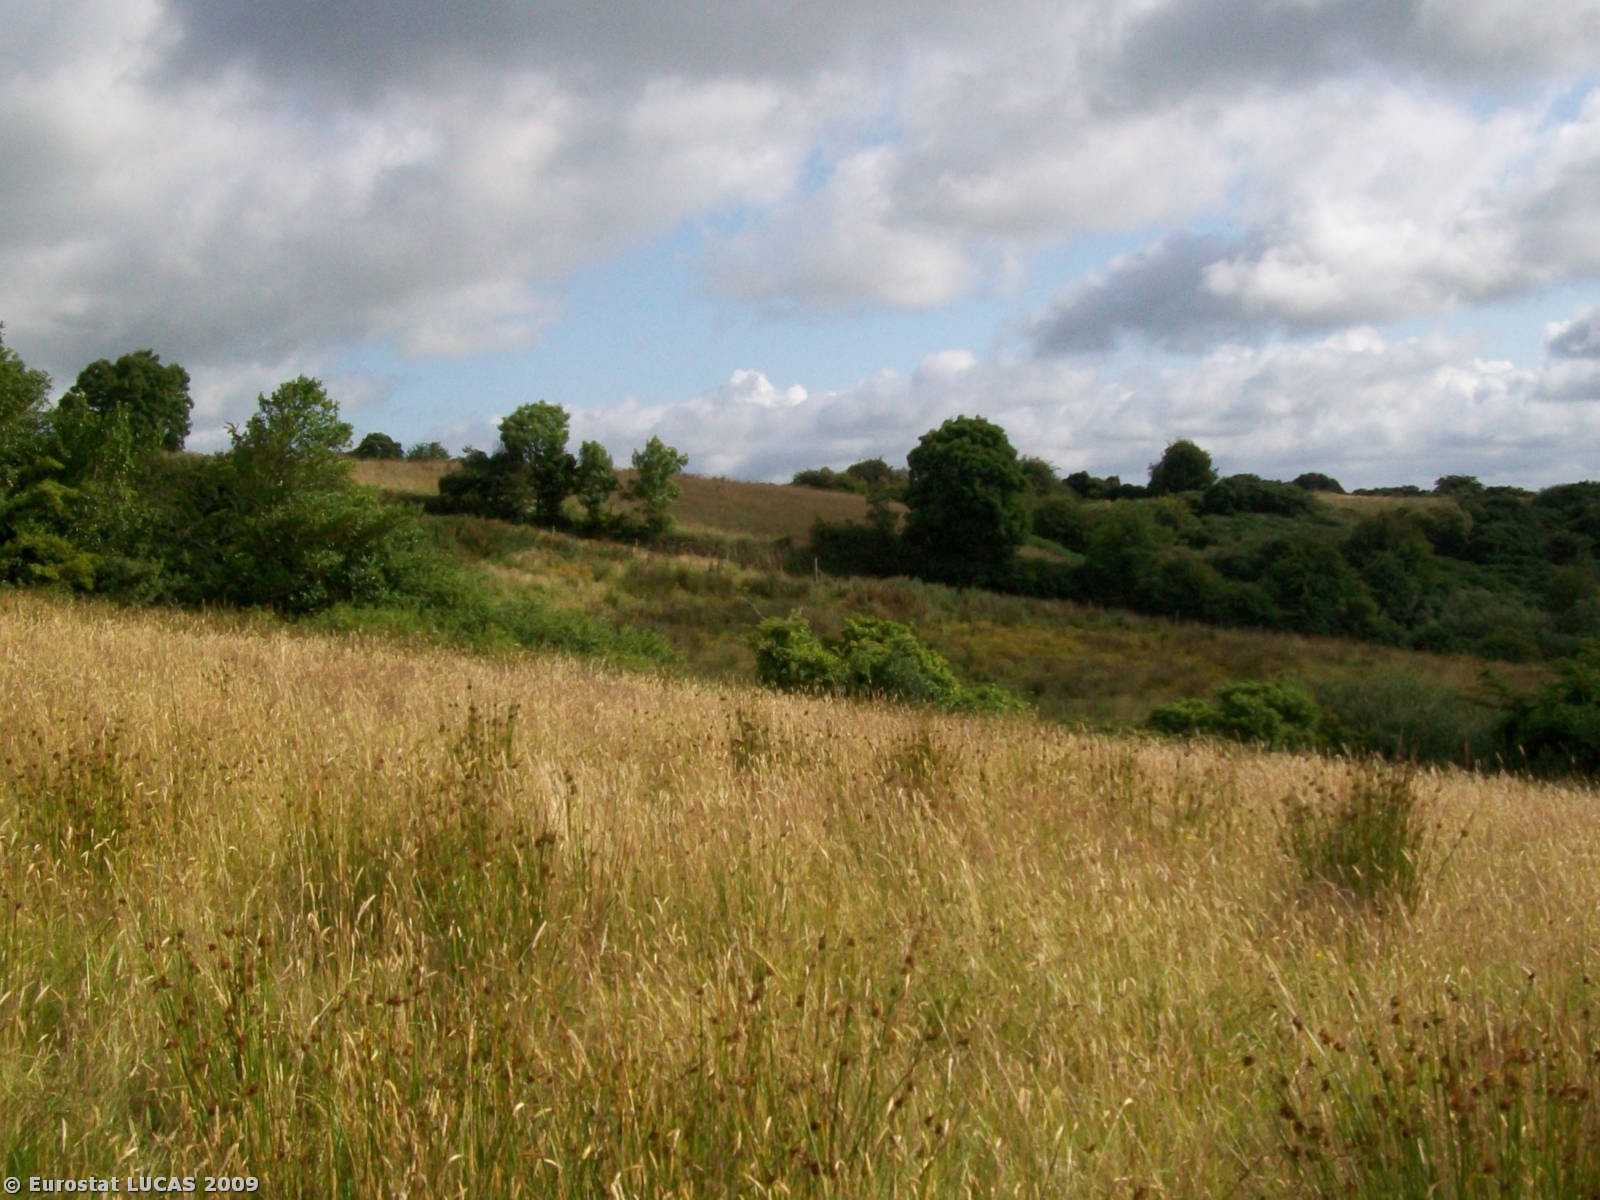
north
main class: Grassland
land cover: Grassland without tree/shrub cover
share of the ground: > 75 %
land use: Agriculture (excluding fallow land and kitchen gardens)
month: July
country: IE
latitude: 53.8498
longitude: -9.0477
